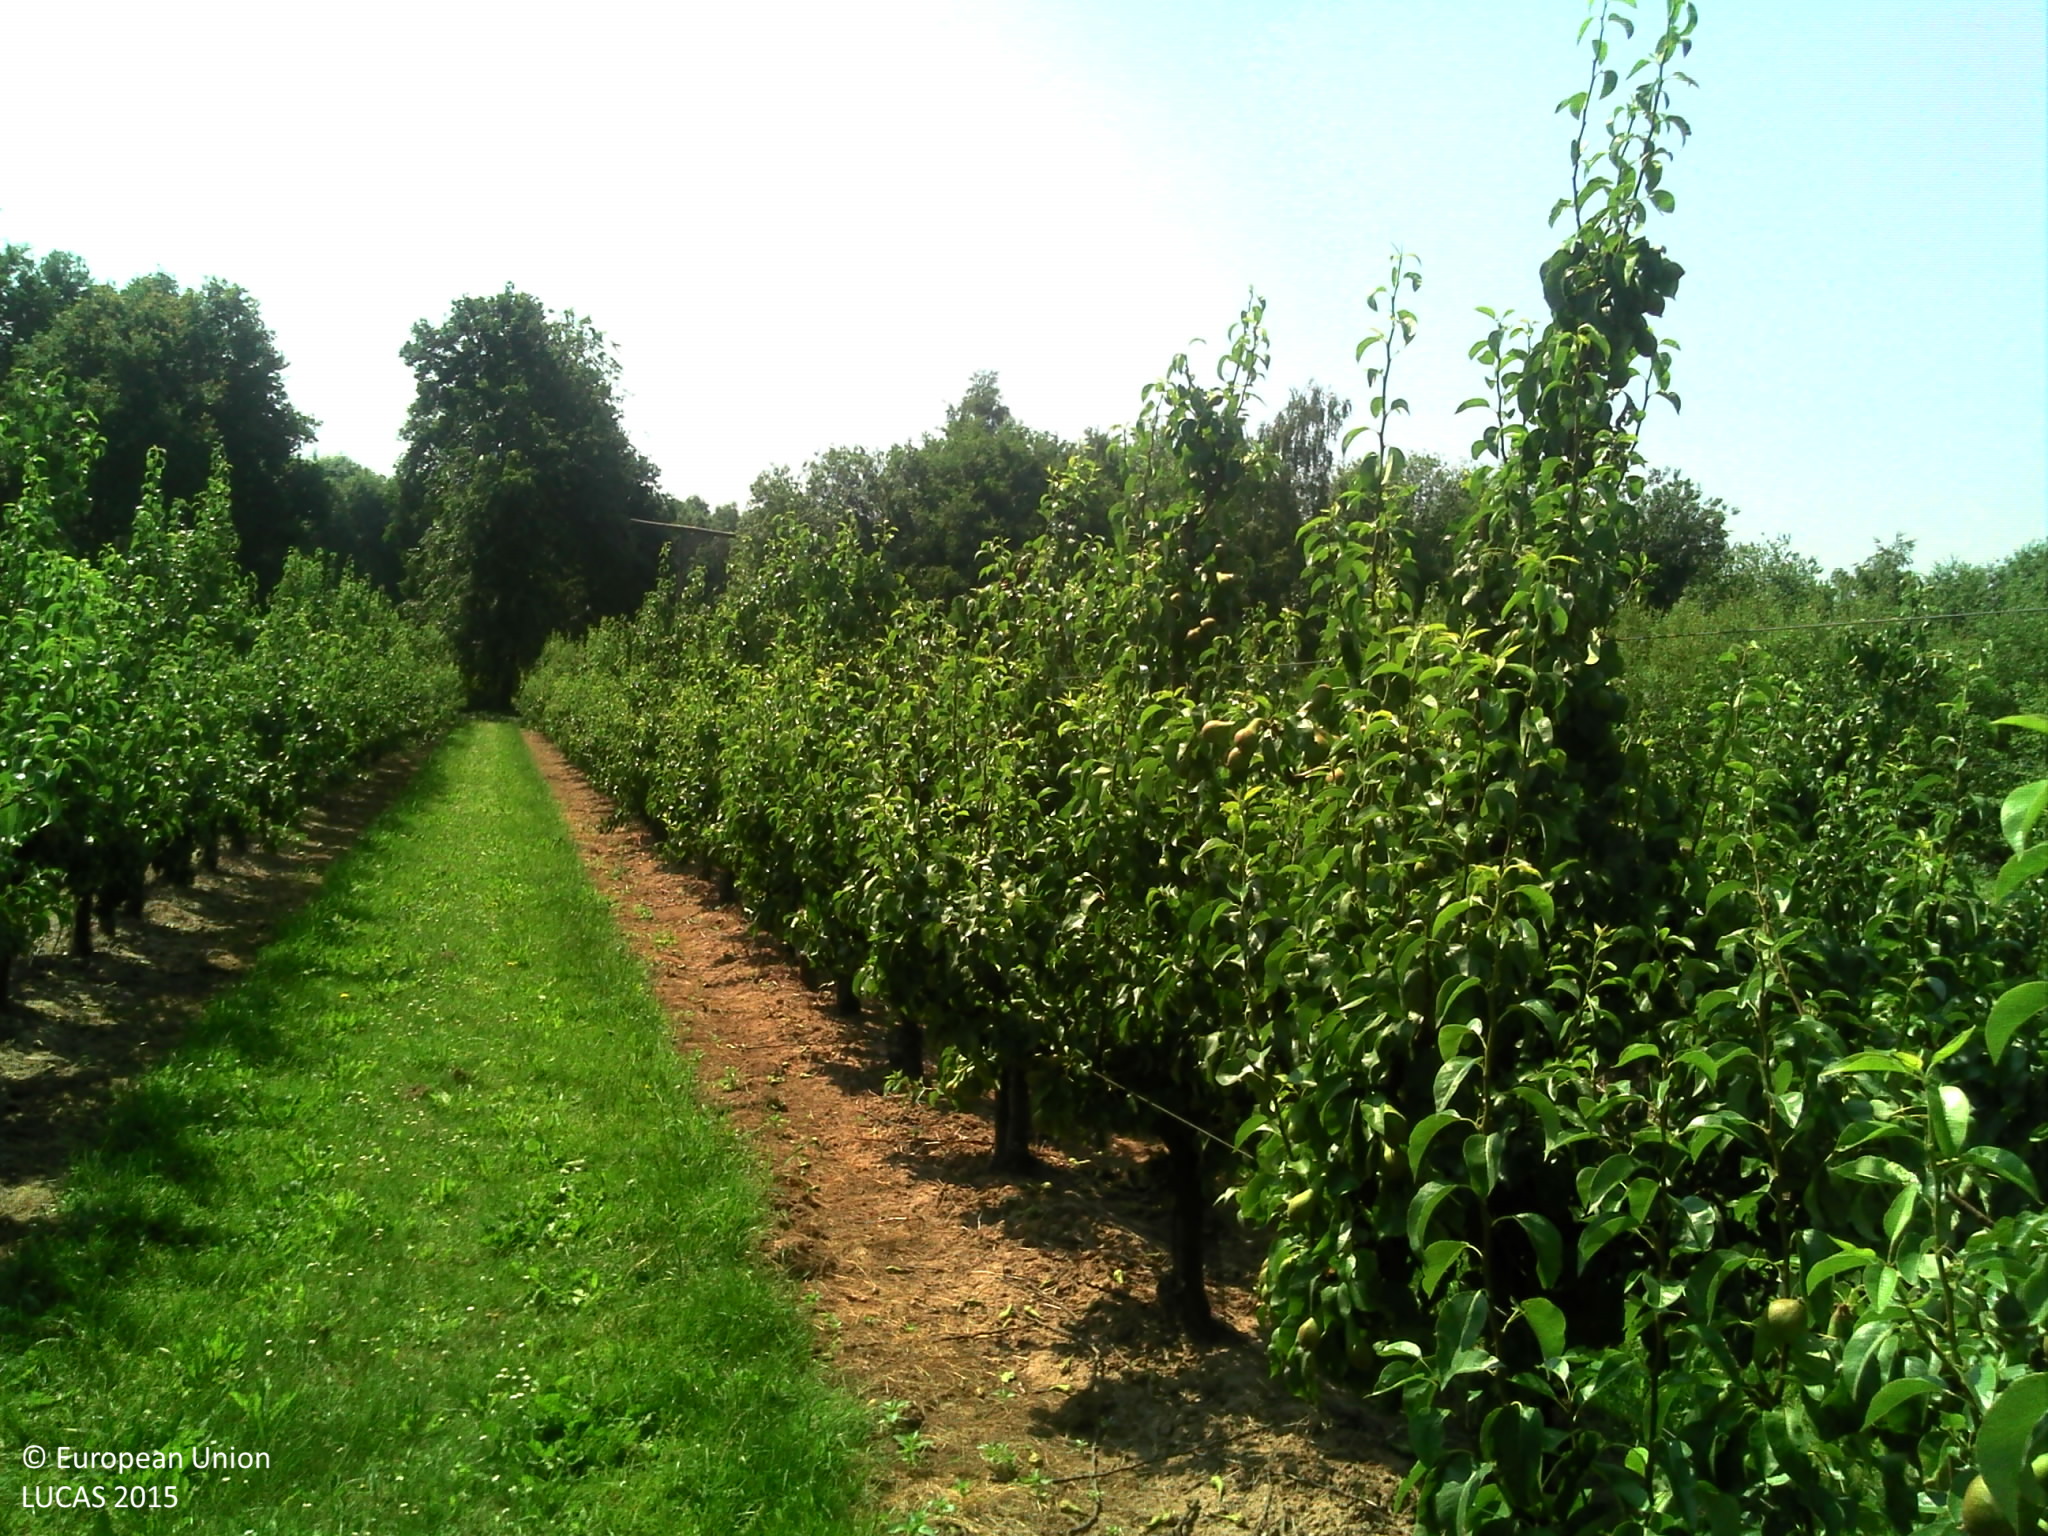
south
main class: Cropland
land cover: Pear fruit
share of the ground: > 75 %
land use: Agriculture (excluding fallow land and kitchen gardens)
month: July
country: BE
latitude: 50.9473
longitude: 4.7728
